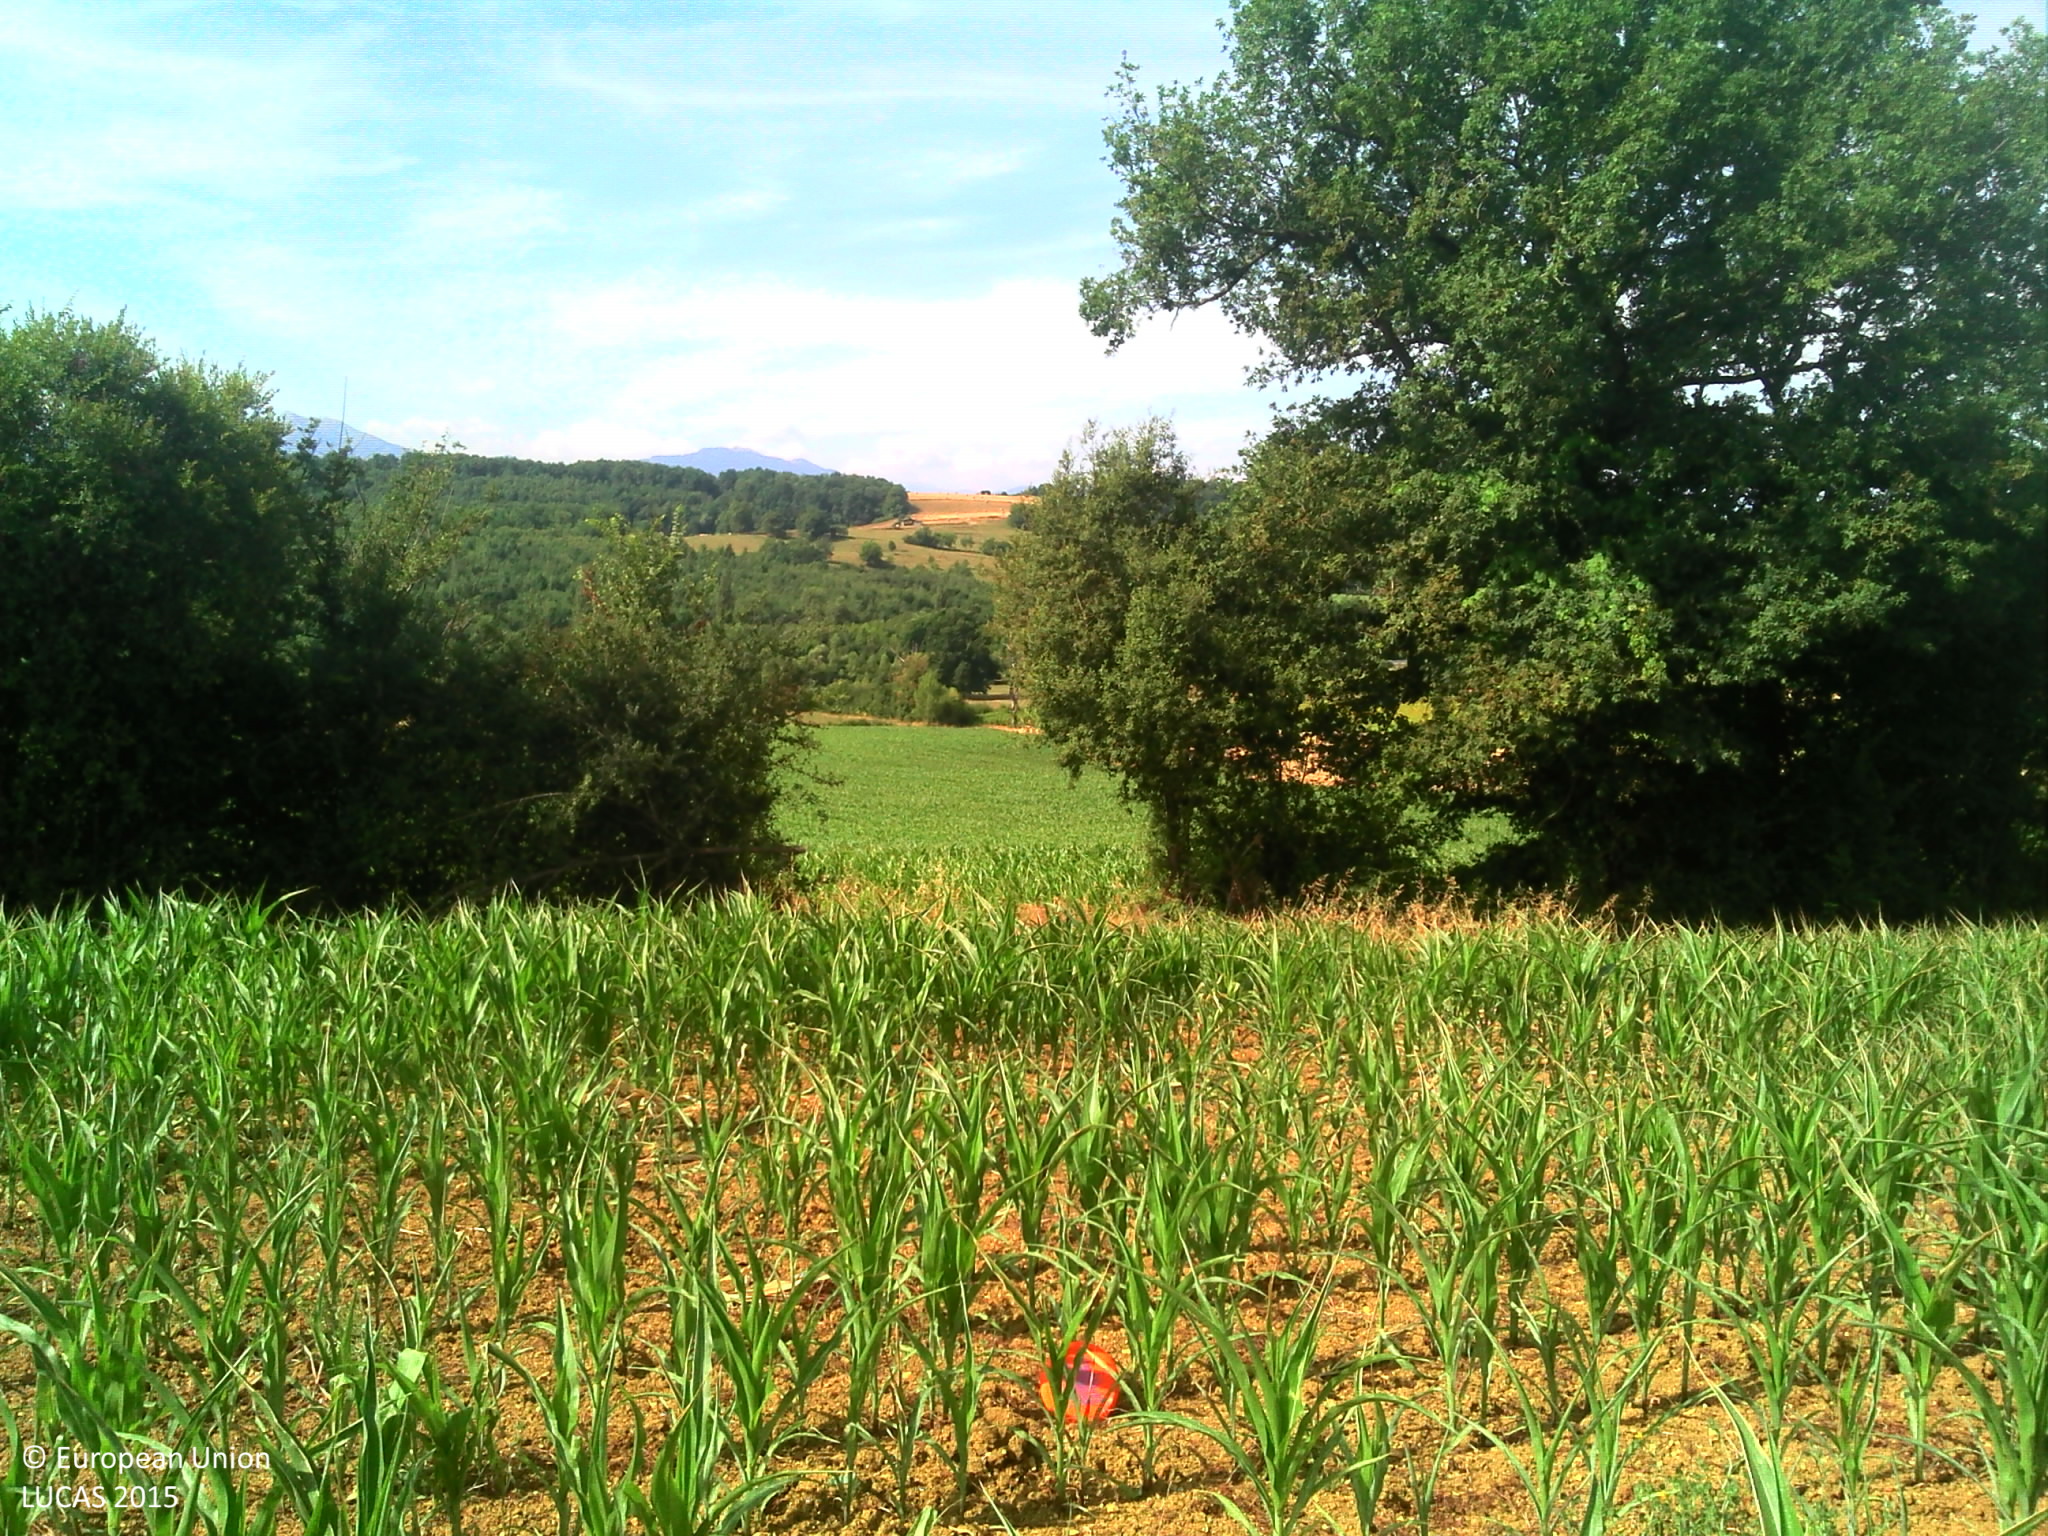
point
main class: Cropland
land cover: Maize
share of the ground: > 75 %
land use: Agriculture (excluding fallow land and kitchen gardens)
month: July
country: FR
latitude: 43.1306
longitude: 0.8690
